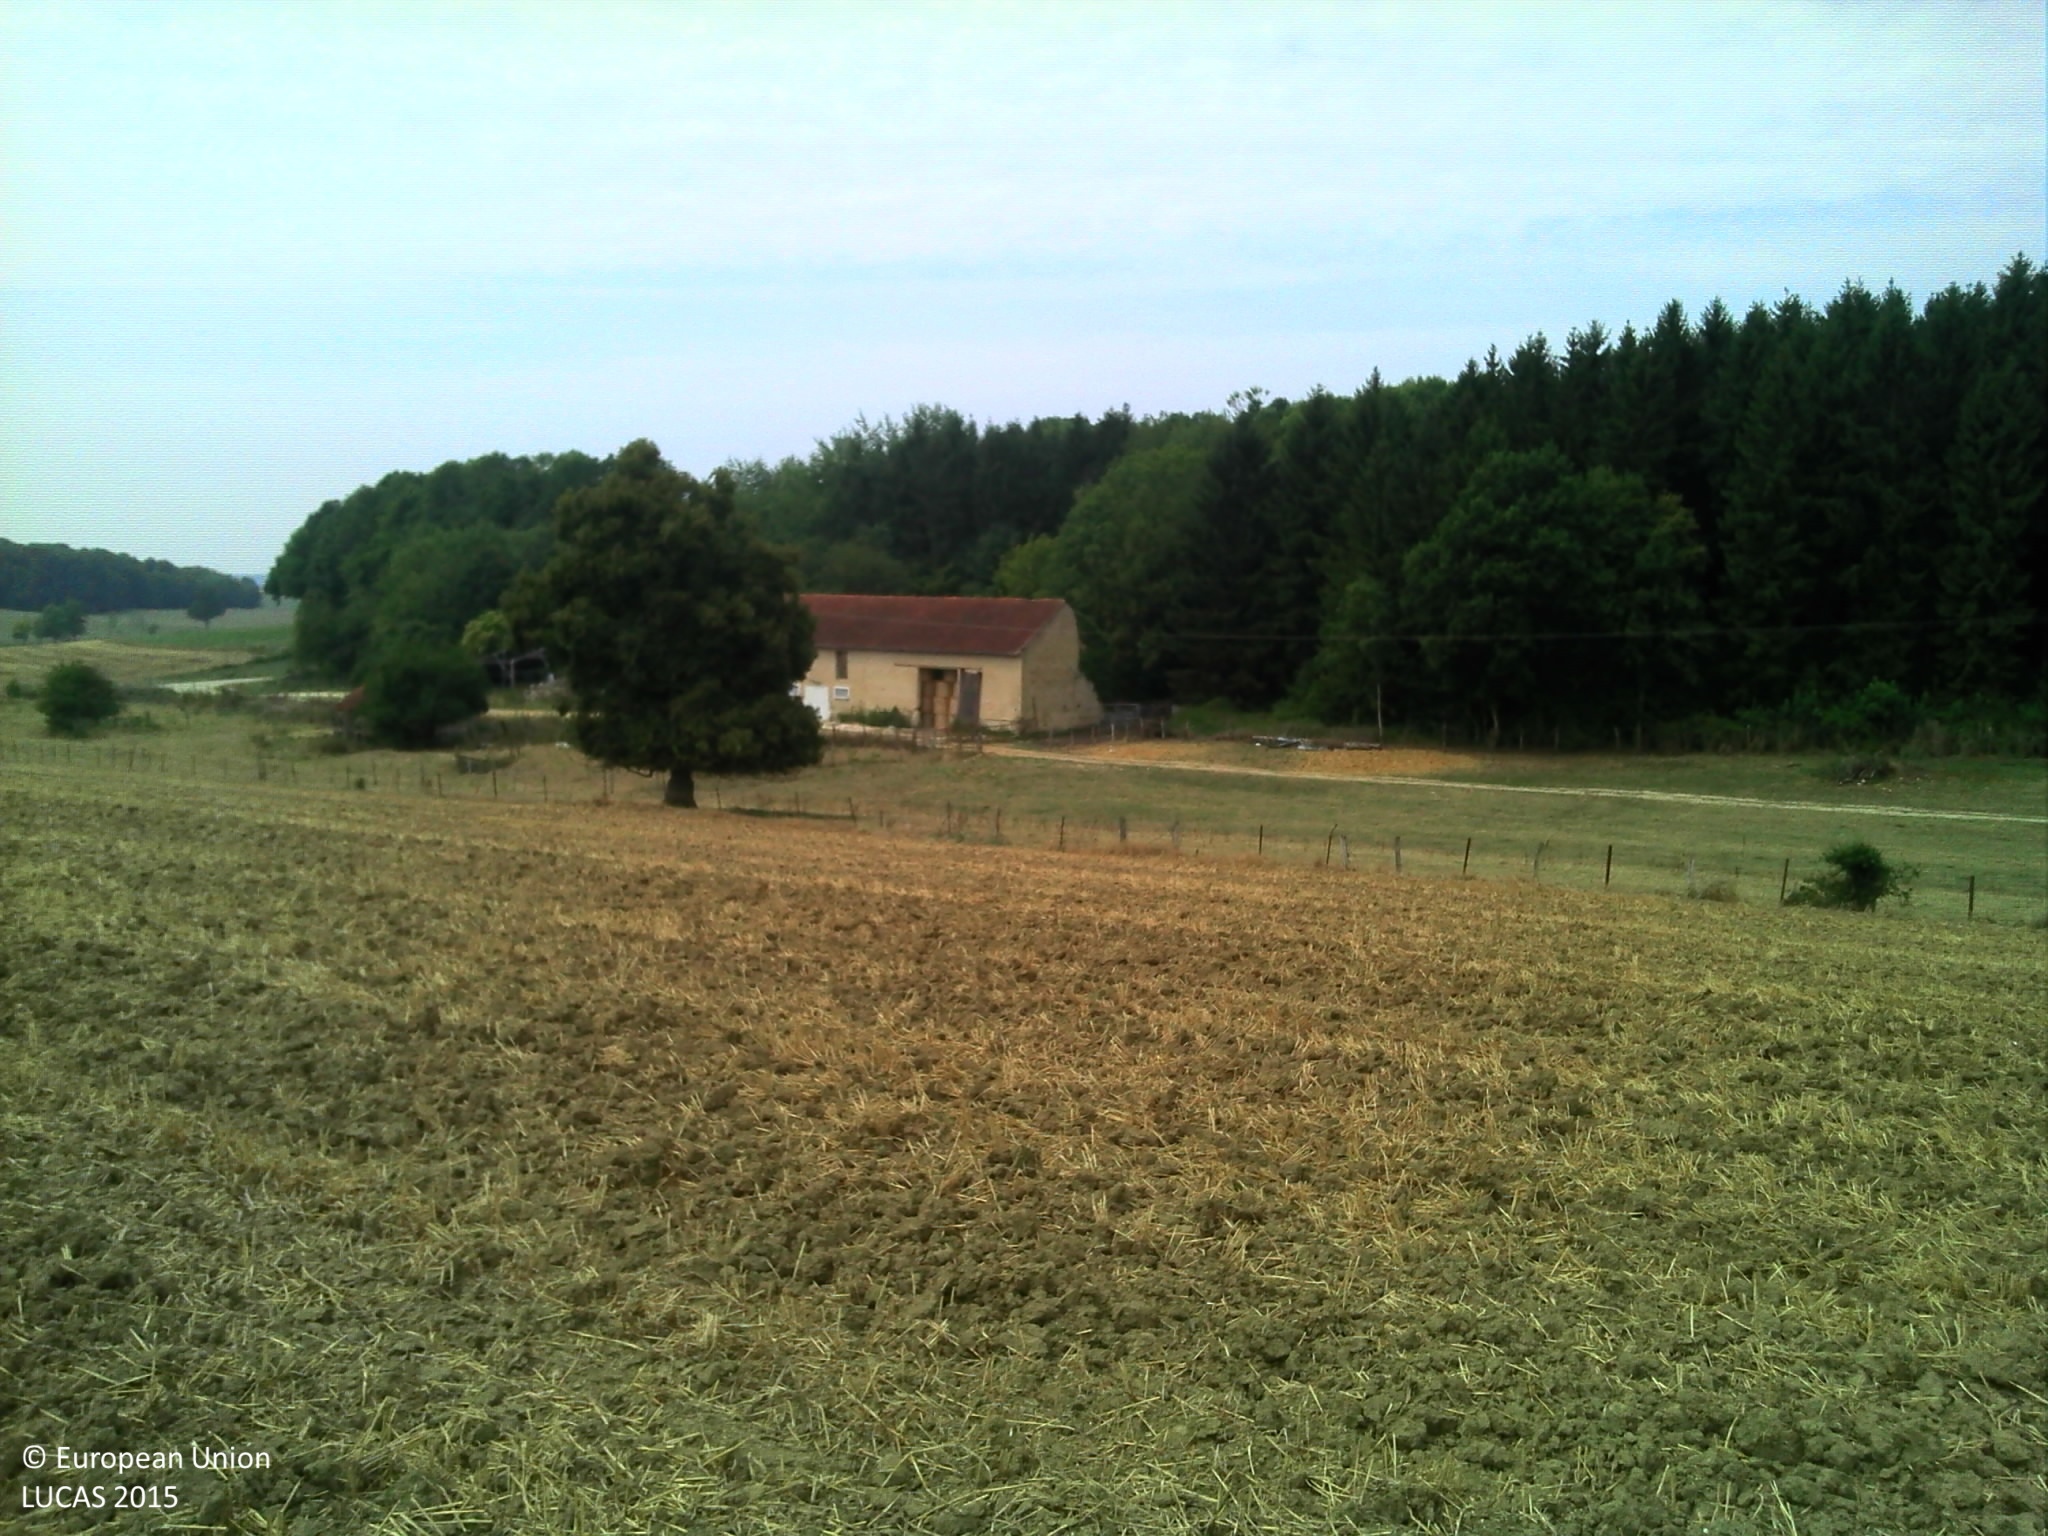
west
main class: Cropland
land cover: Common wheat
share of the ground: < 10 %
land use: Agriculture (excluding fallow land and kitchen gardens)
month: August
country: FR
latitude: 49.3371
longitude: 5.0295
